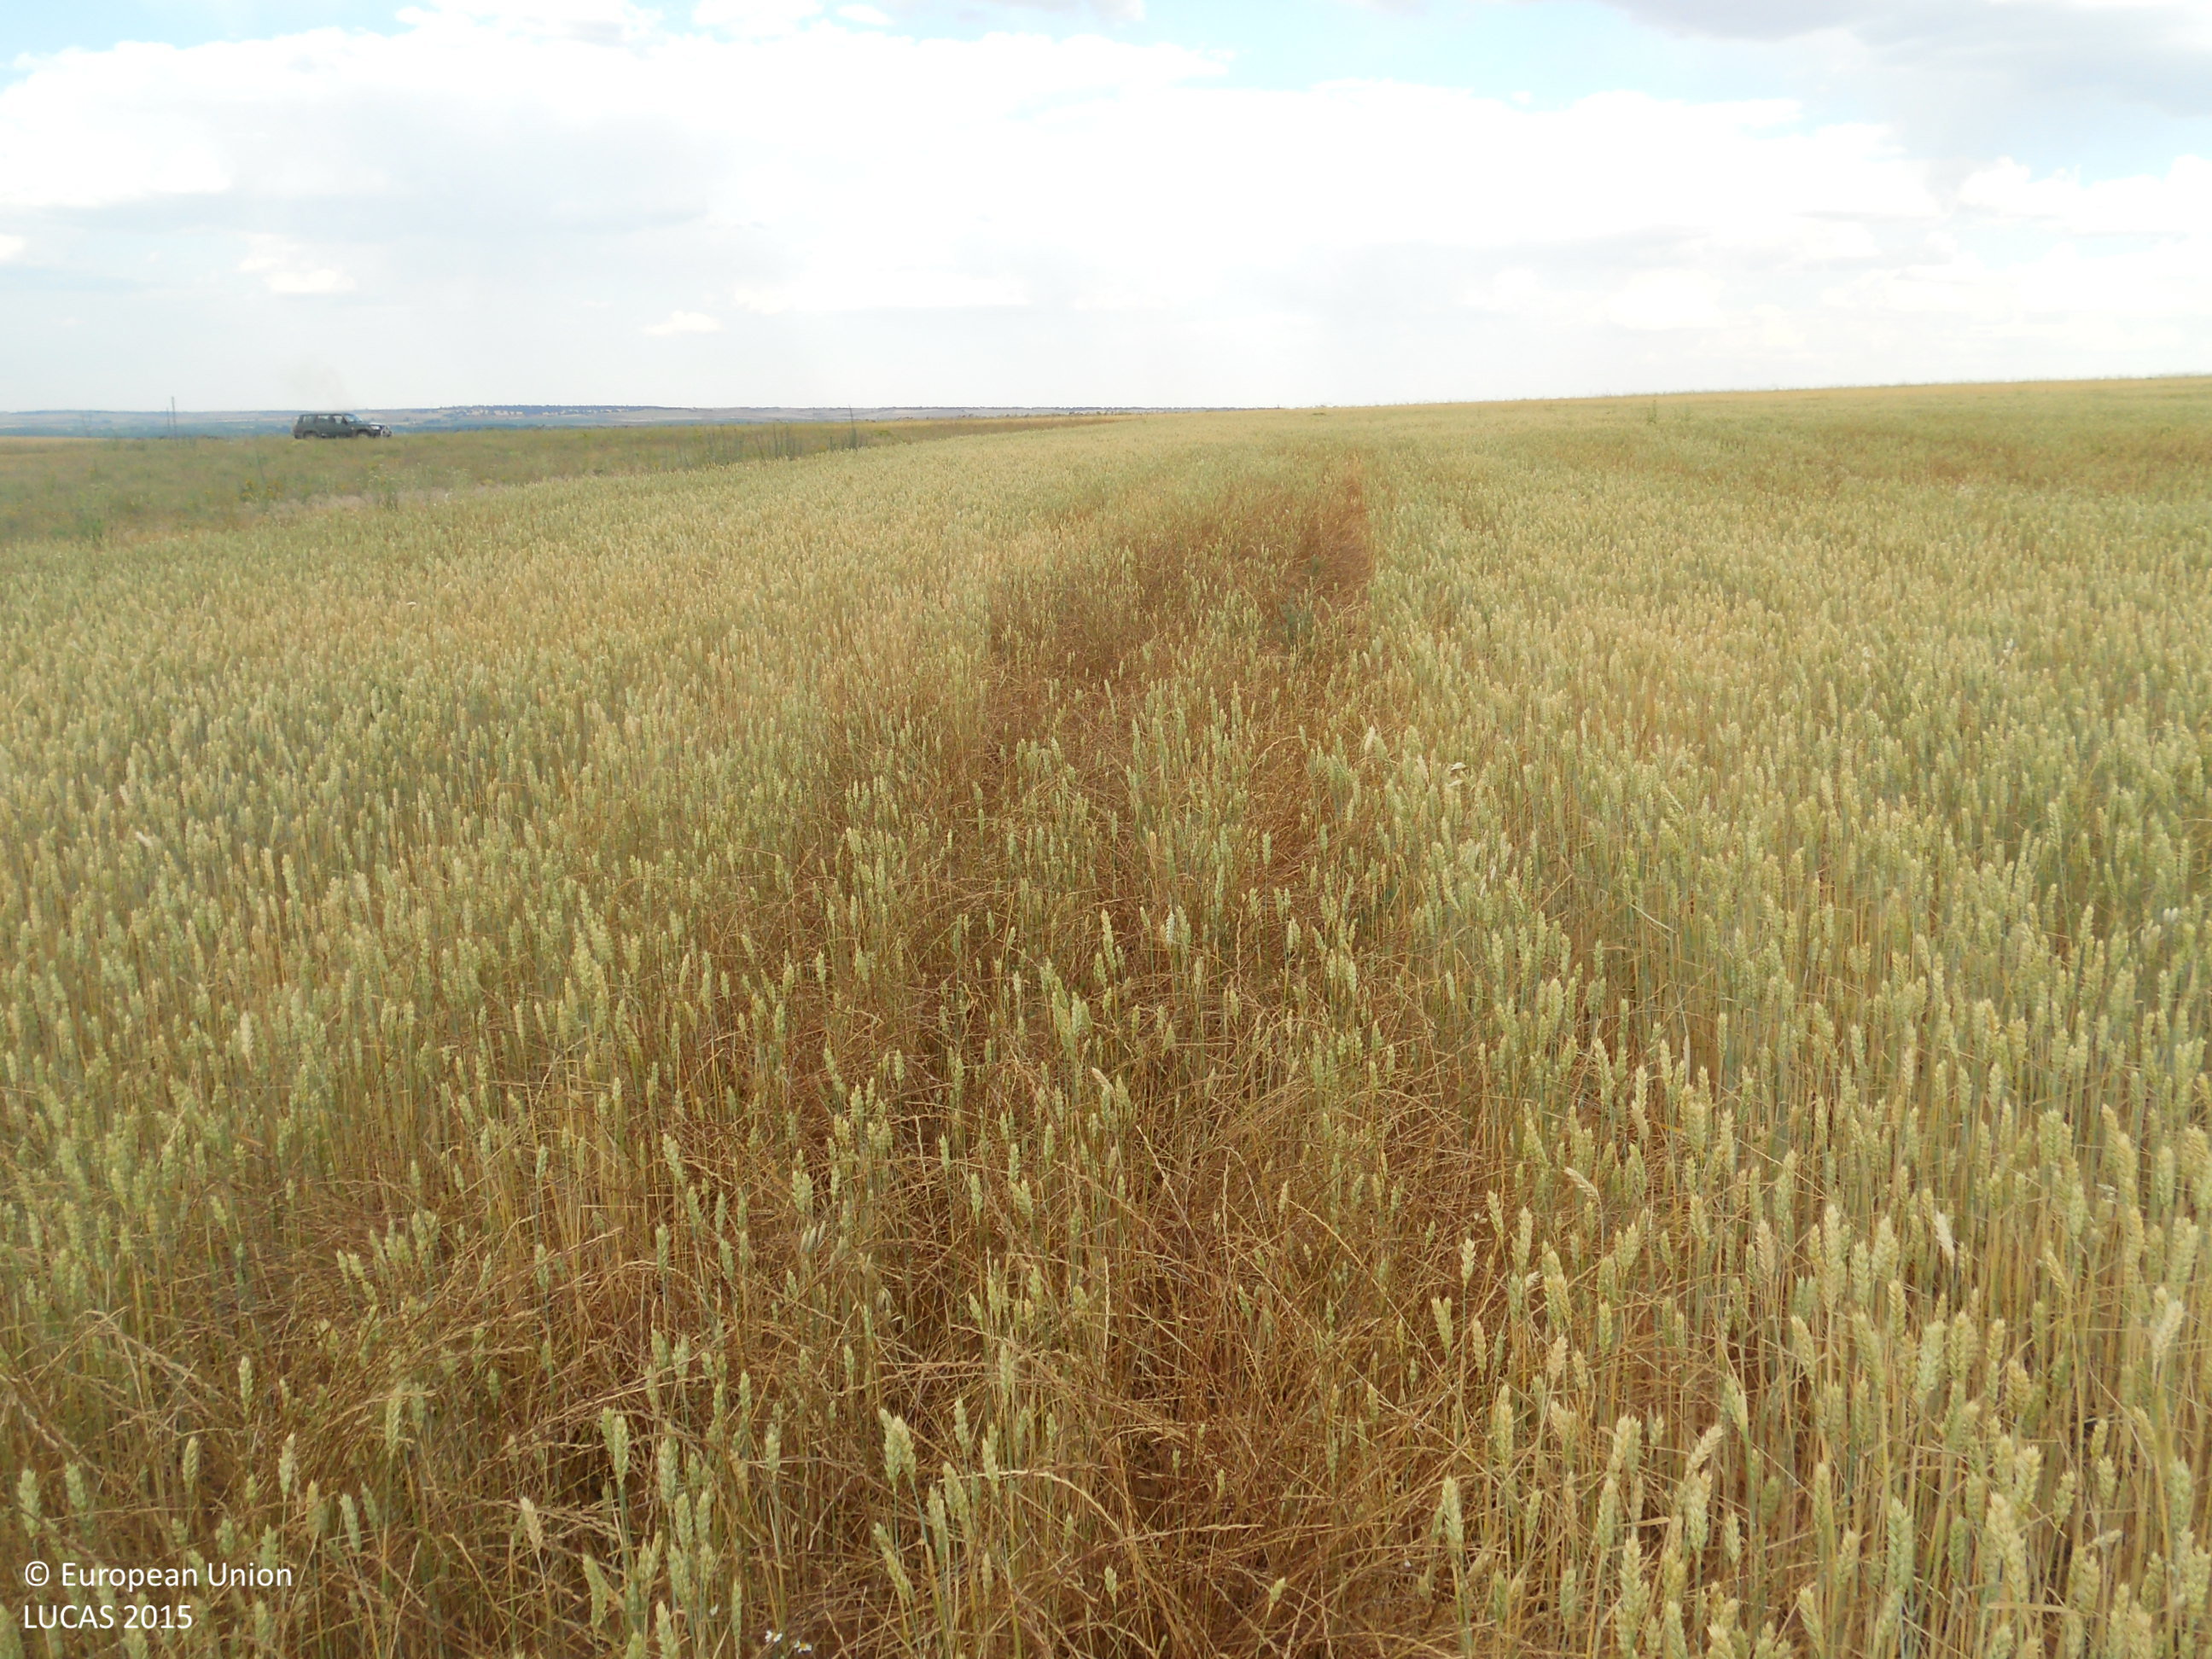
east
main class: Cropland
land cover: Common wheat
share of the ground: > 75 %
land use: Agriculture (excluding fallow land and kitchen gardens)
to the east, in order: Common wheat; Grass margins; Barley; Spontaneously vegetated surfaces; Other leguminous and mixtures for fodder
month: June
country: ES
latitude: 42.2064
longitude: -5.6085
